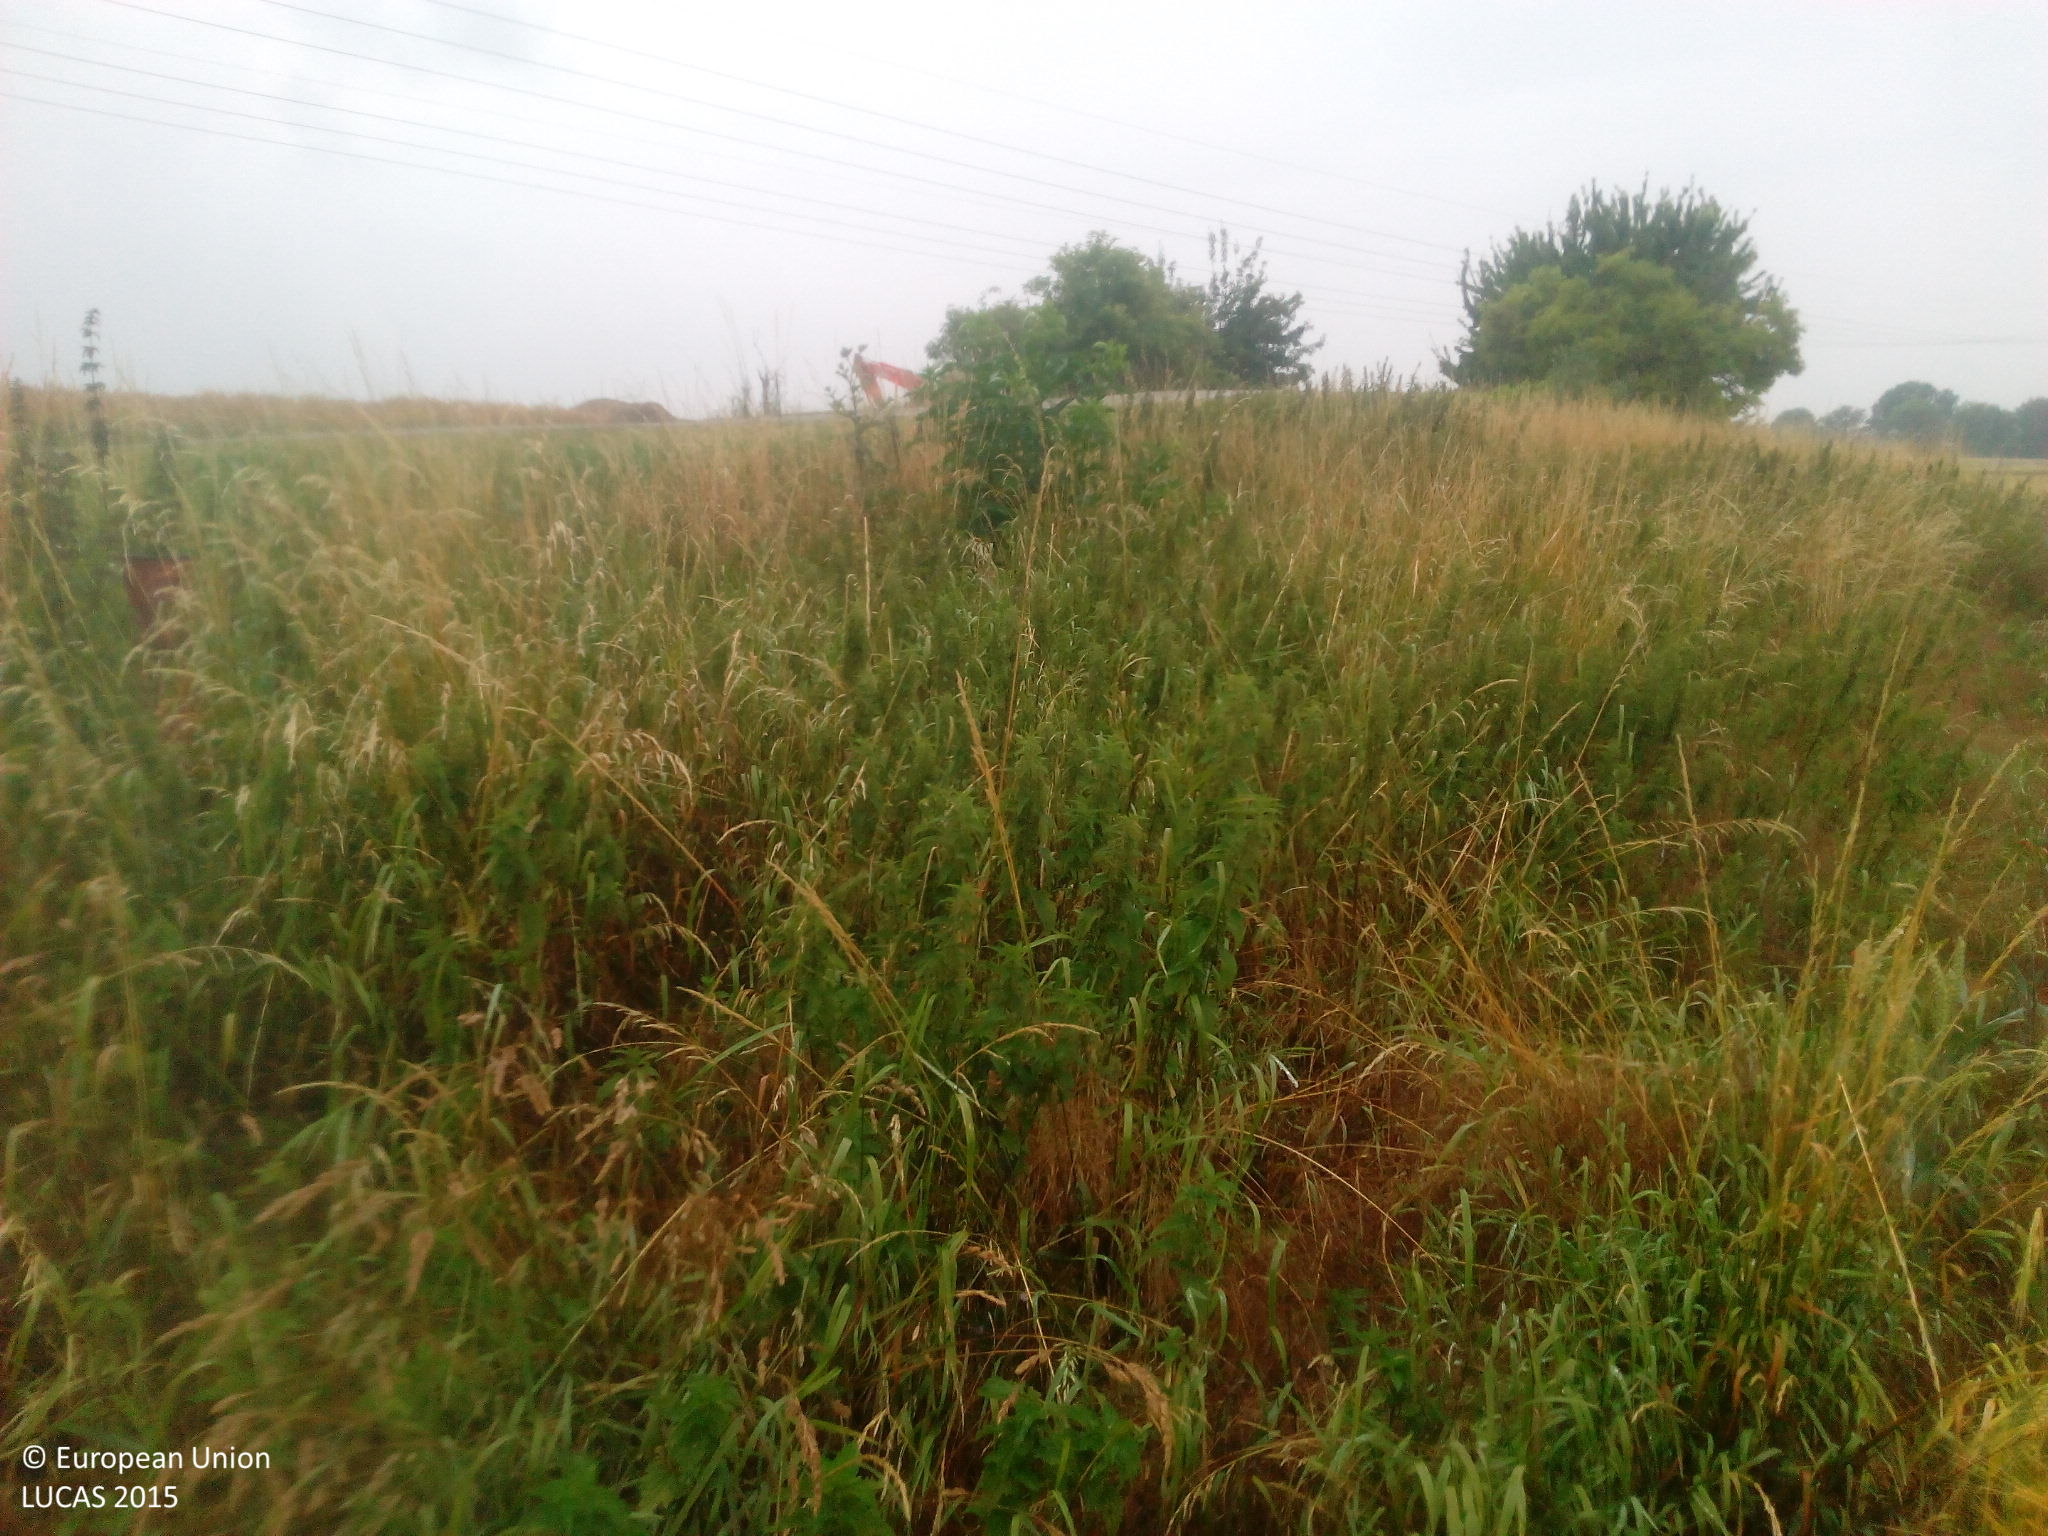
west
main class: Cropland
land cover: Barley
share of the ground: > 75 %
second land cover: Common wheat
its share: < 10 %
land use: Agriculture (excluding fallow land and kitchen gardens)
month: July
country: DE
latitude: 51.8999
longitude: 11.5547
